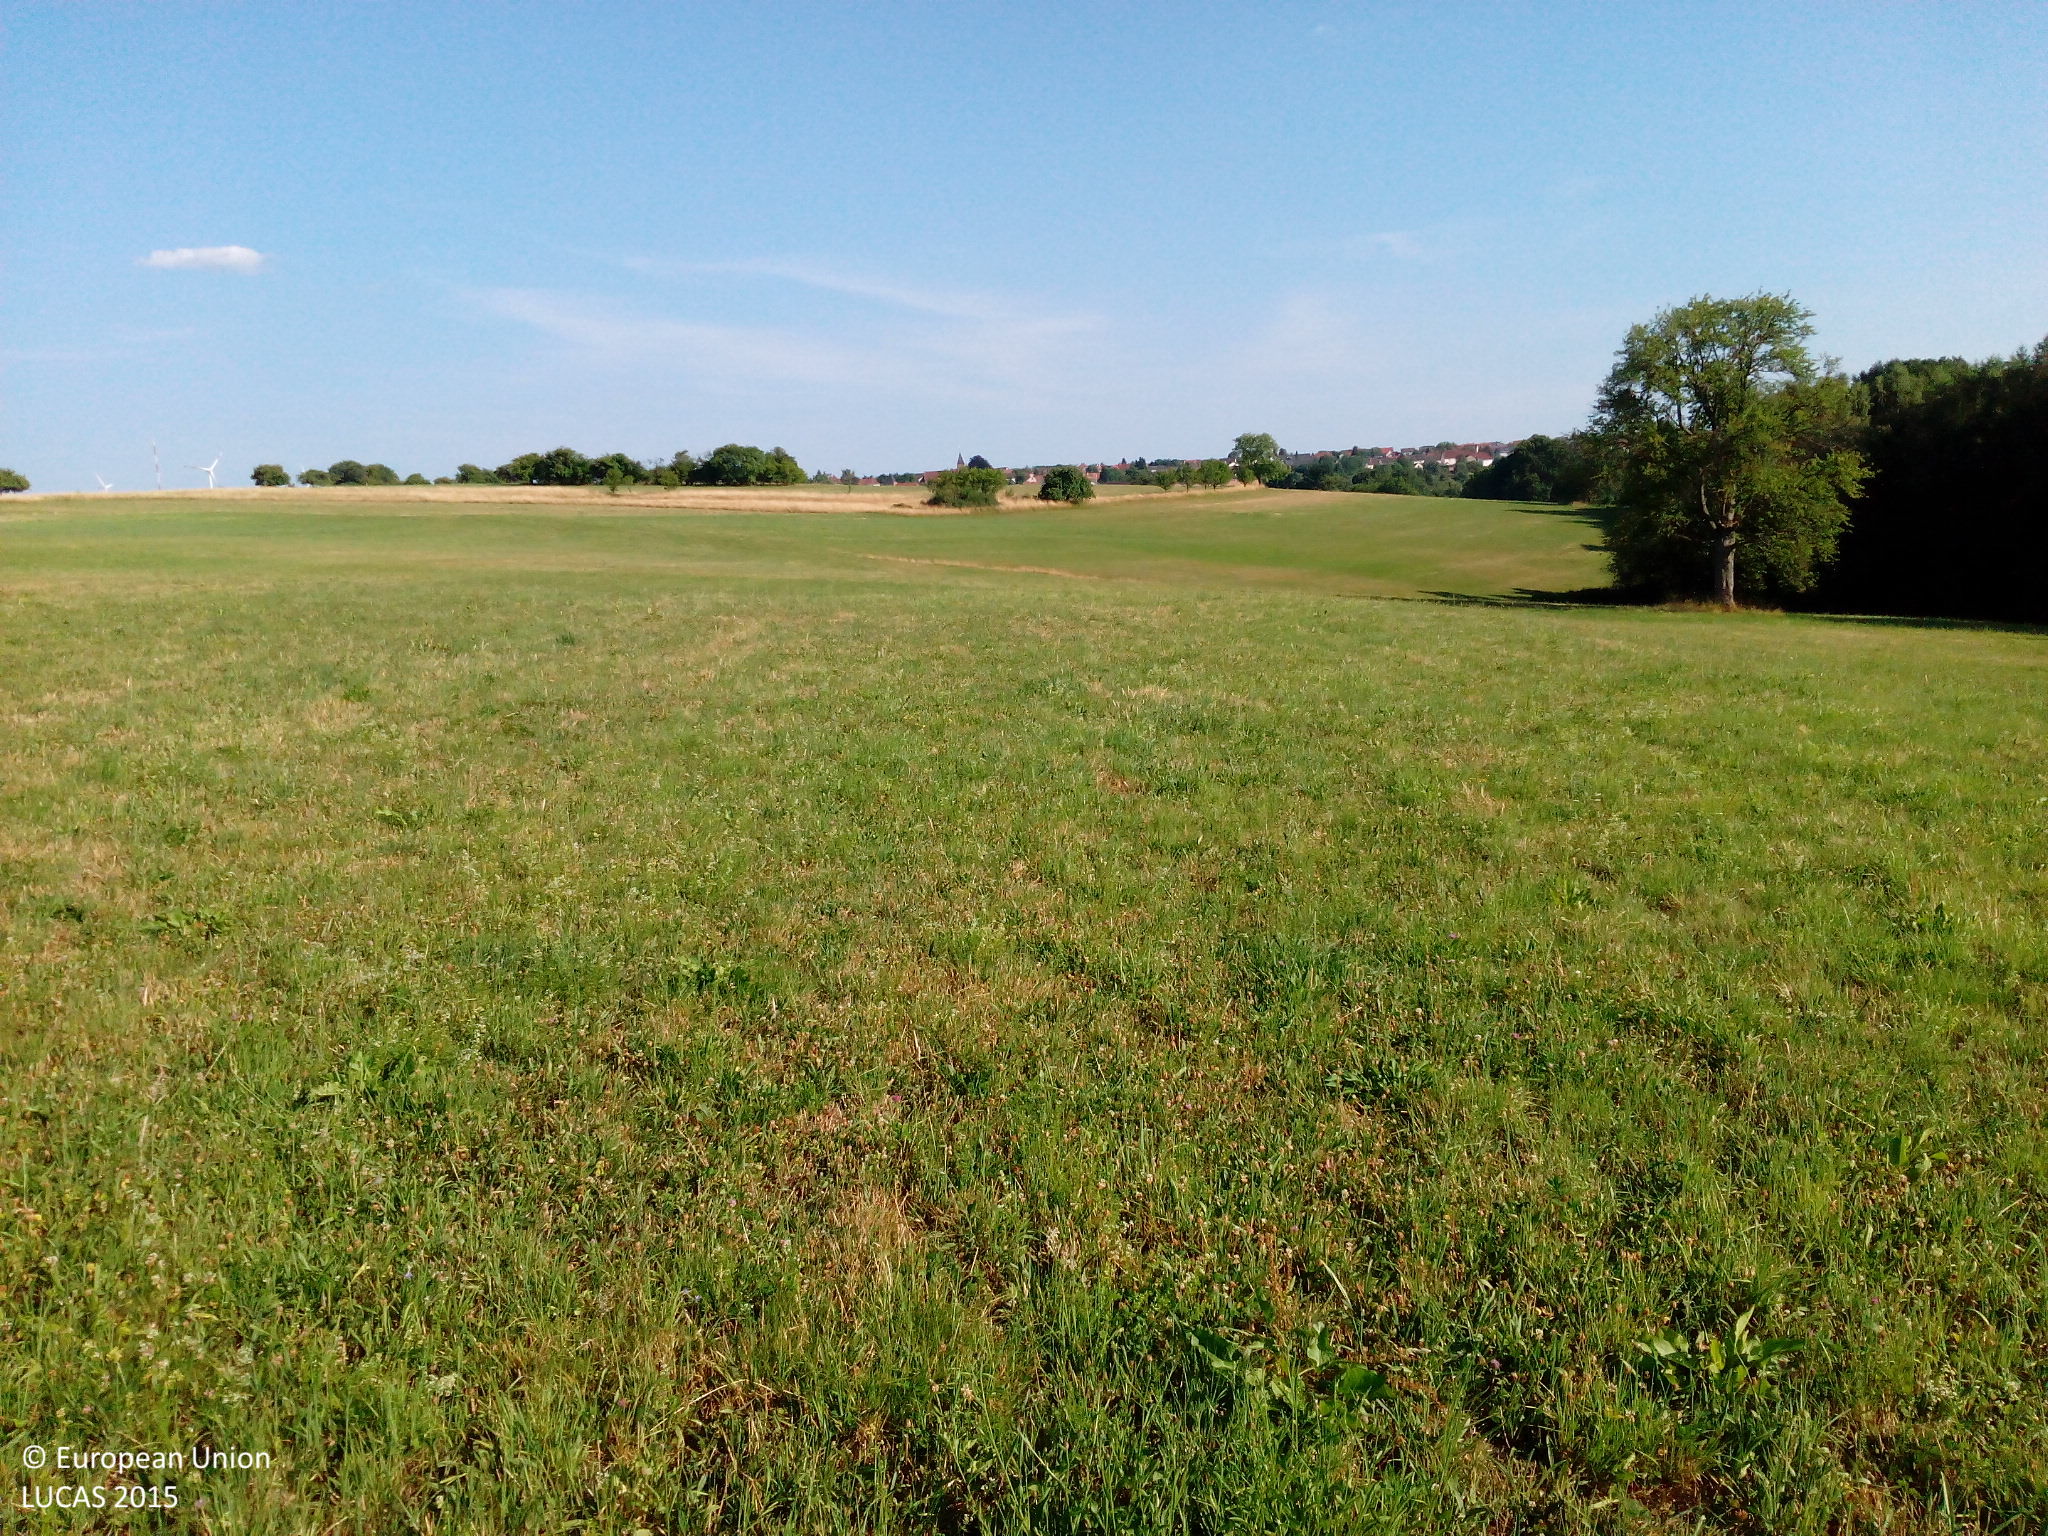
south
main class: Grassland
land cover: Grassland without tree/shrub cover
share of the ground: > 75 %
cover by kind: herbaceous plants 90 %, unconsolidated bare surface 10 %
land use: Agriculture (excluding fallow land and kitchen gardens)
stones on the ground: < 10 %
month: July
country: DE
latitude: 49.1682
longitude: 7.5455
